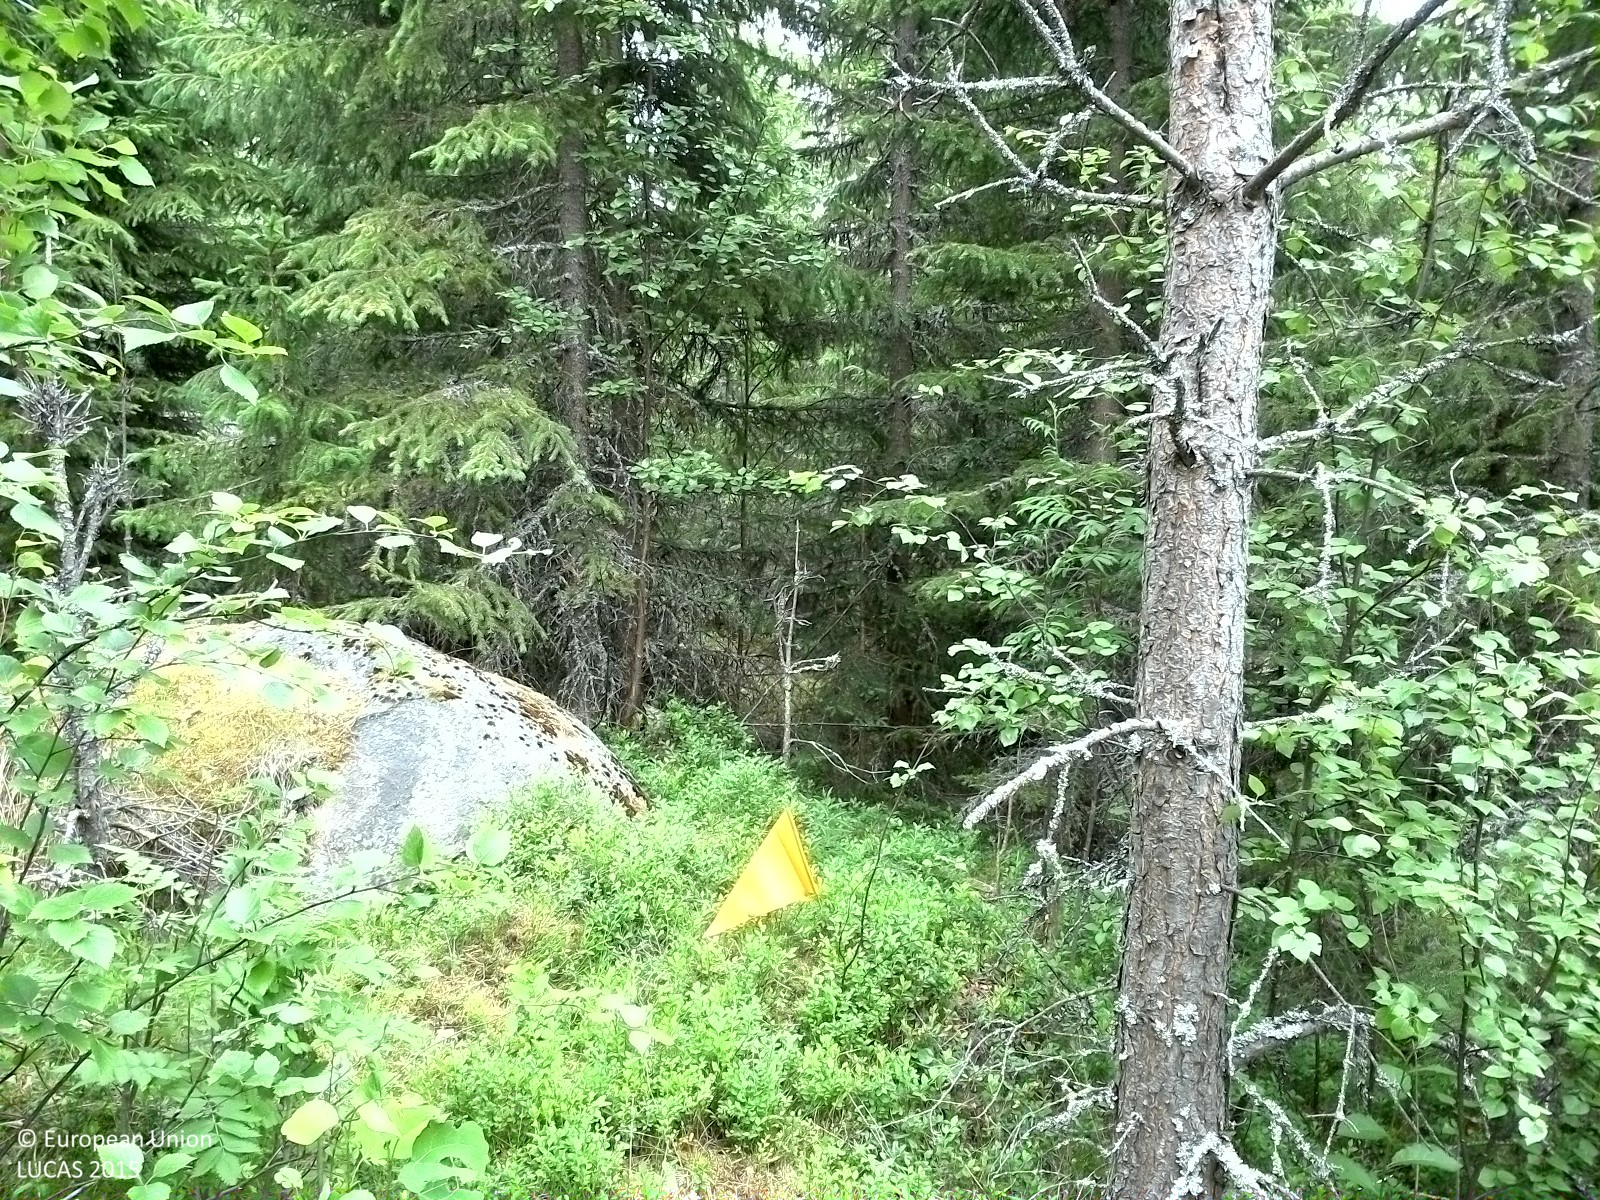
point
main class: Woodland
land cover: Spruce dominated mixed woodland
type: boreal forest
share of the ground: 25 - 50 %
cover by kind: coniferous forest trees 30 %, herbaceous plants 30 %, broadleaved forest trees 20 %, shrubs 15 %, lichens and mosses 5 %
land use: Forestry
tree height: > 5 m
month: July
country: SE
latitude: 62.1727
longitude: 16.7211
